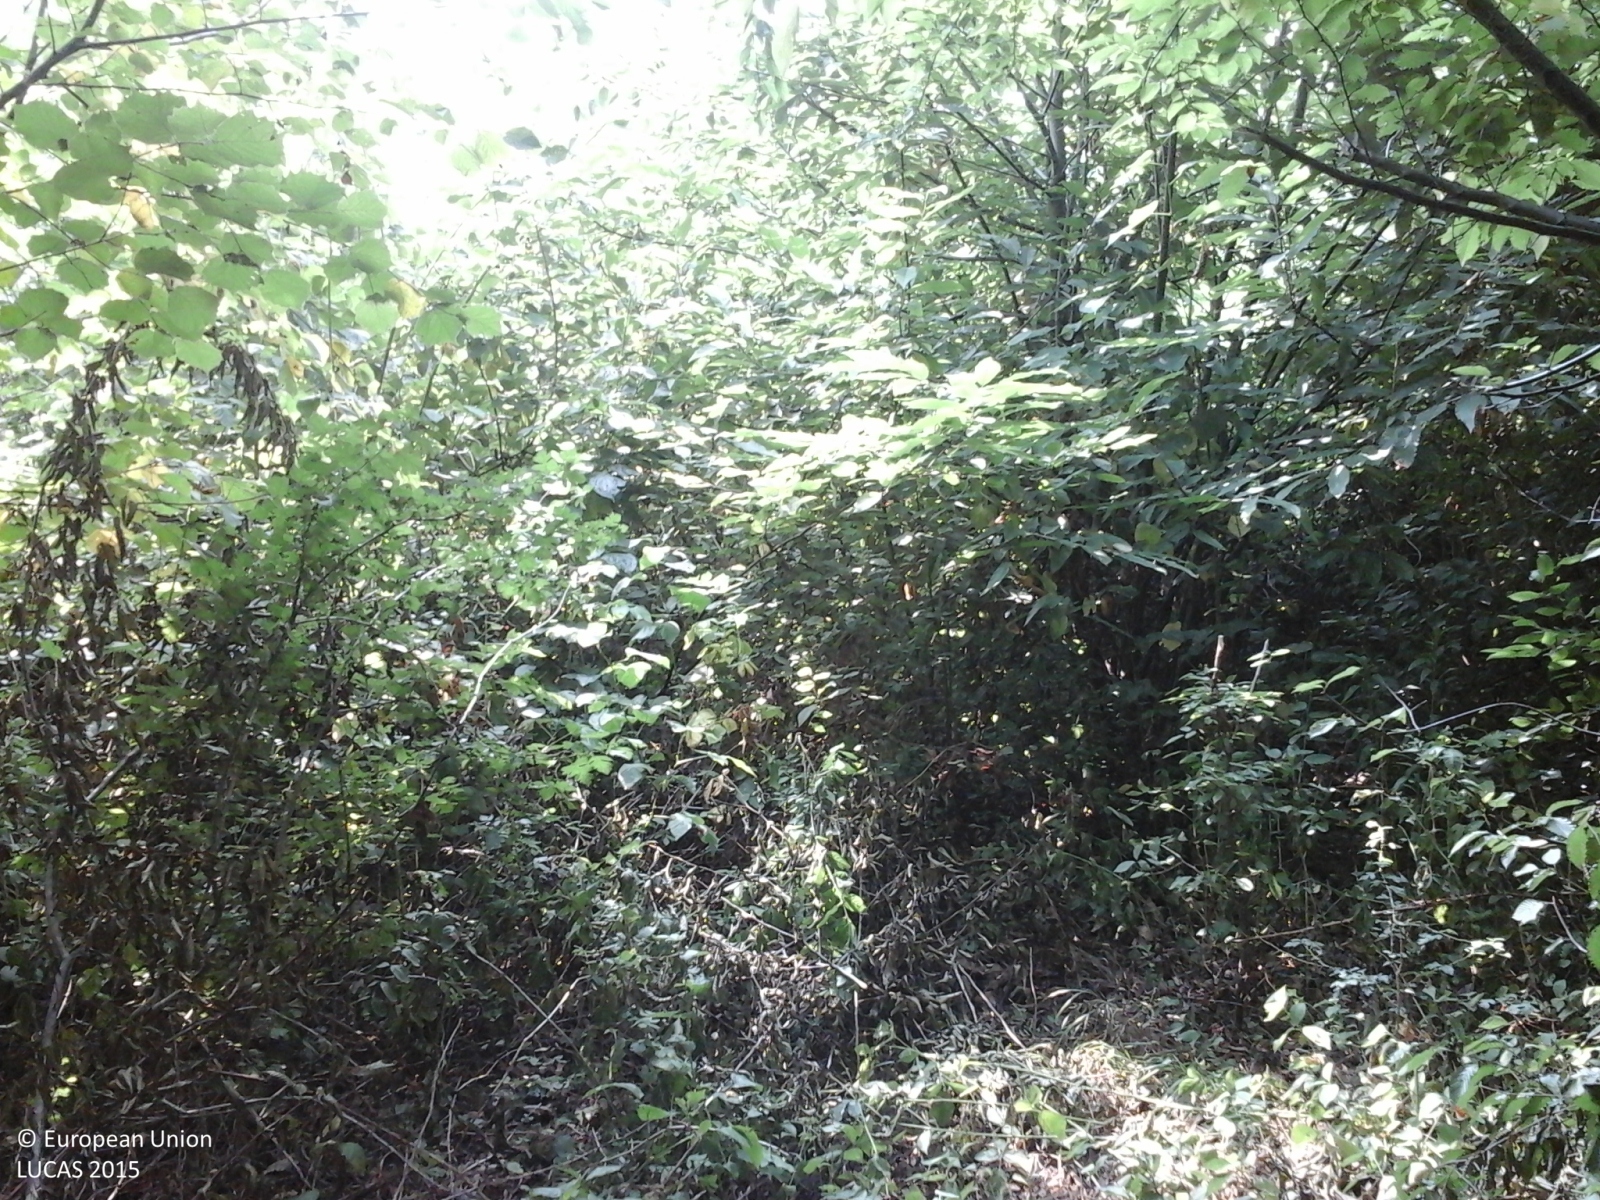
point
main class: Woodland
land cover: Broadleaved woodland
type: thermophilous deciduous forest
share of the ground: > 75 %
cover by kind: broadleaved forest trees 100 %
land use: Forestry
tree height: > 5 m
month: July
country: IT
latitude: 45.3907
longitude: 7.7683
